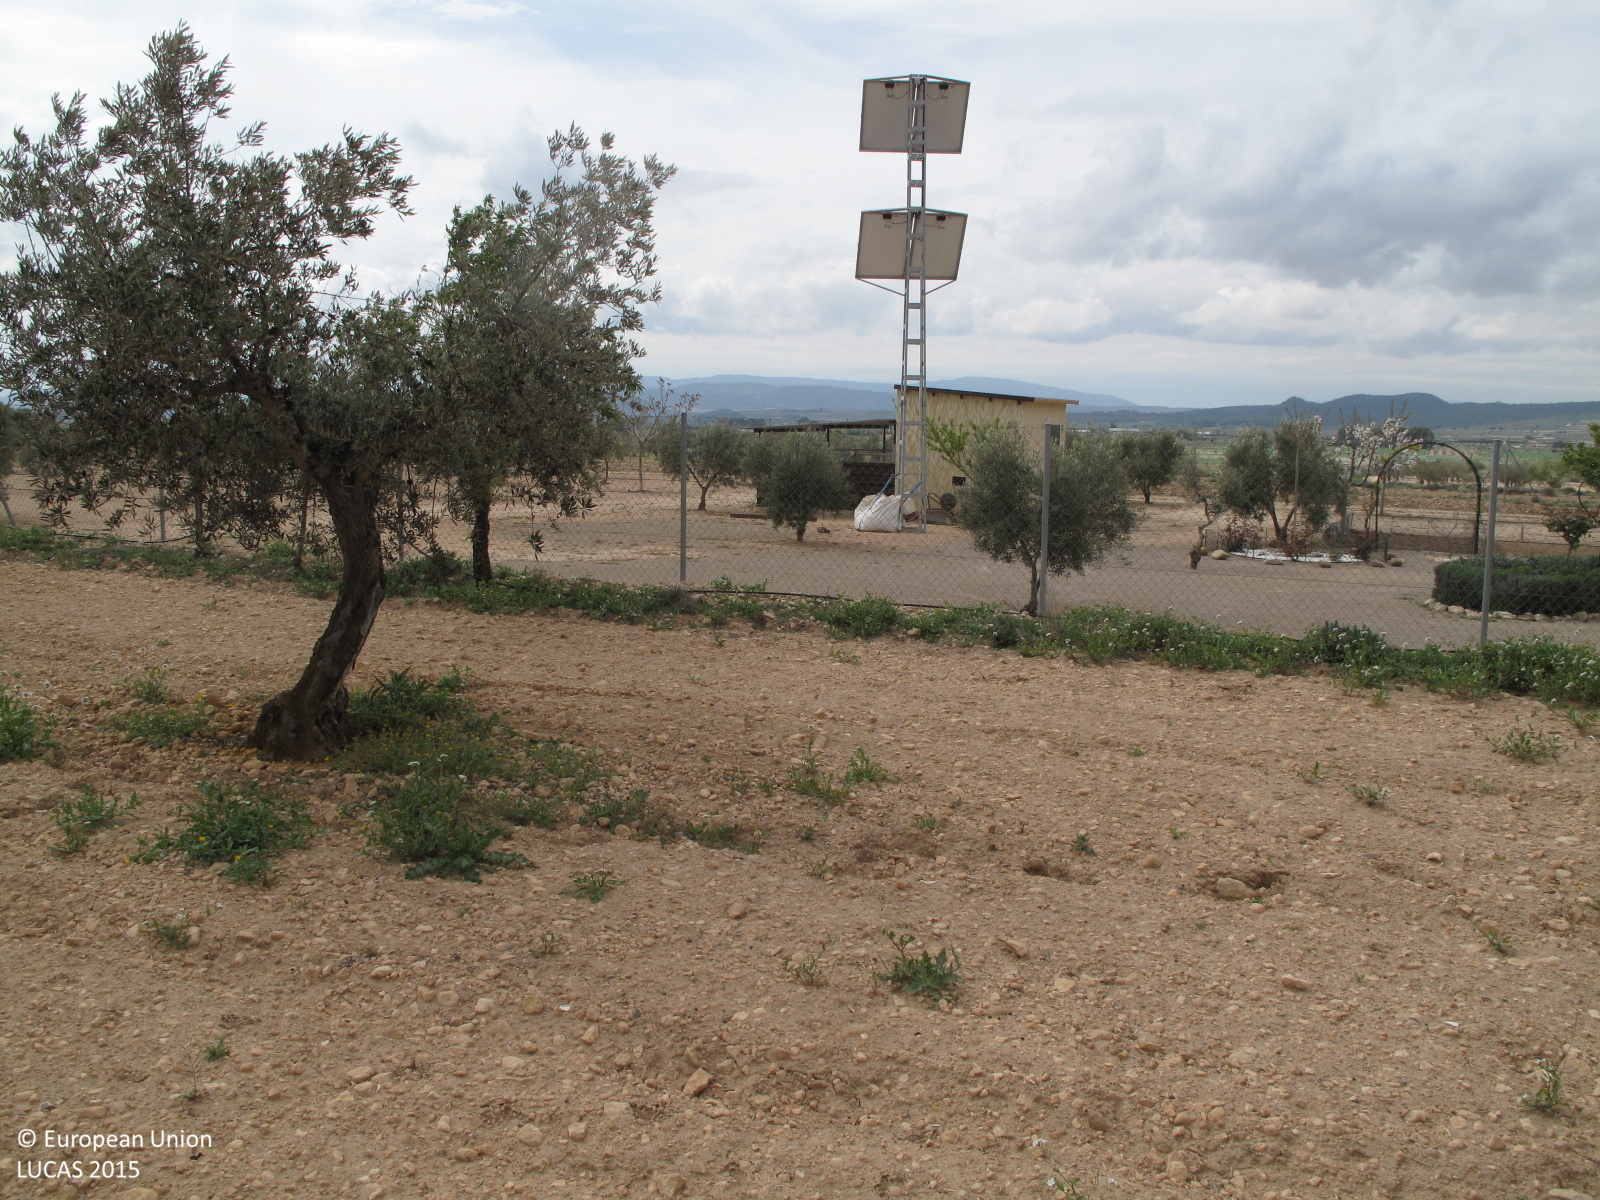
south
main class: Cropland
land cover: Olive groves
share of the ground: 10 - 25 %
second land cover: Other bare soil
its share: > 75 %
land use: Agriculture (excluding fallow land and kitchen gardens)
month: April
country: ES
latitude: 38.7033
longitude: -0.9498
